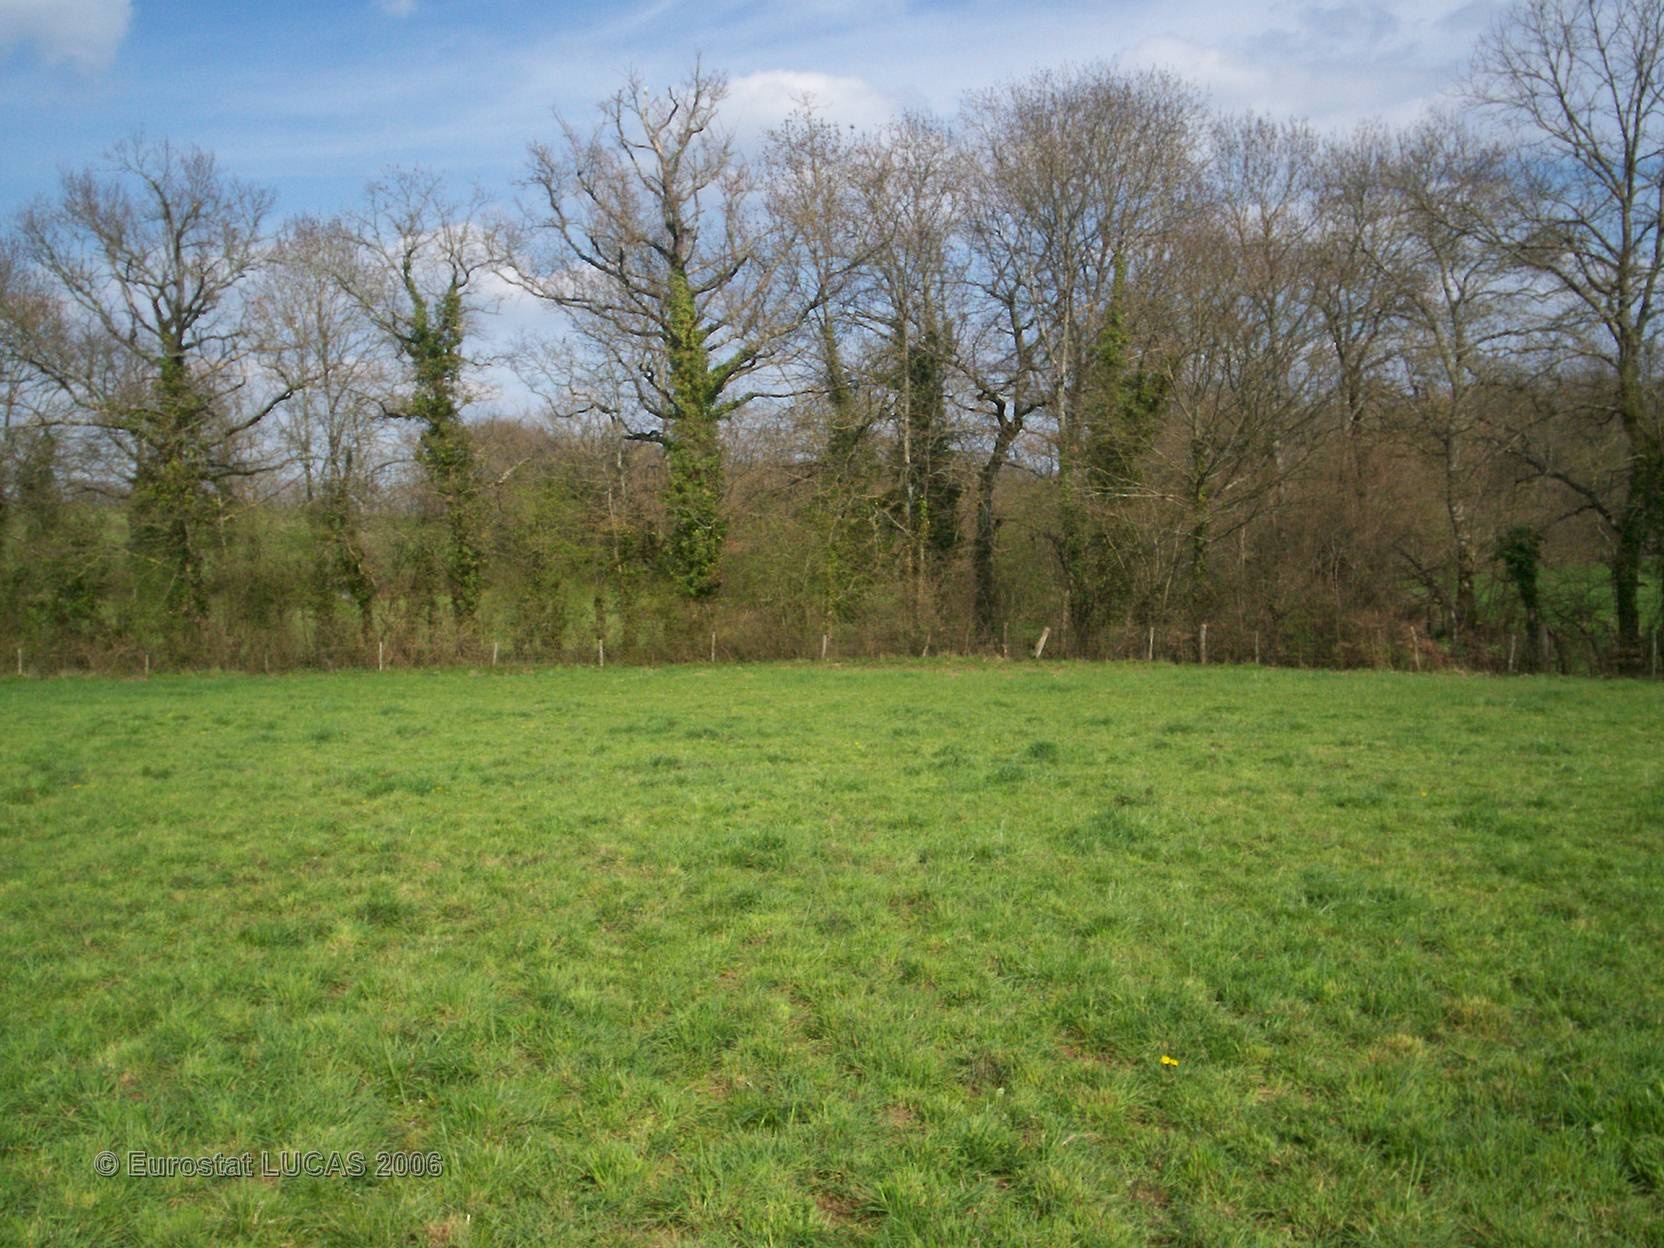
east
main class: Grassland
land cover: Grassland without tree/shrub cover
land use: Agriculture (excluding fallow land and kitchen gardens)
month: April
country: FR
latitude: 46.2358
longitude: 1.1314
